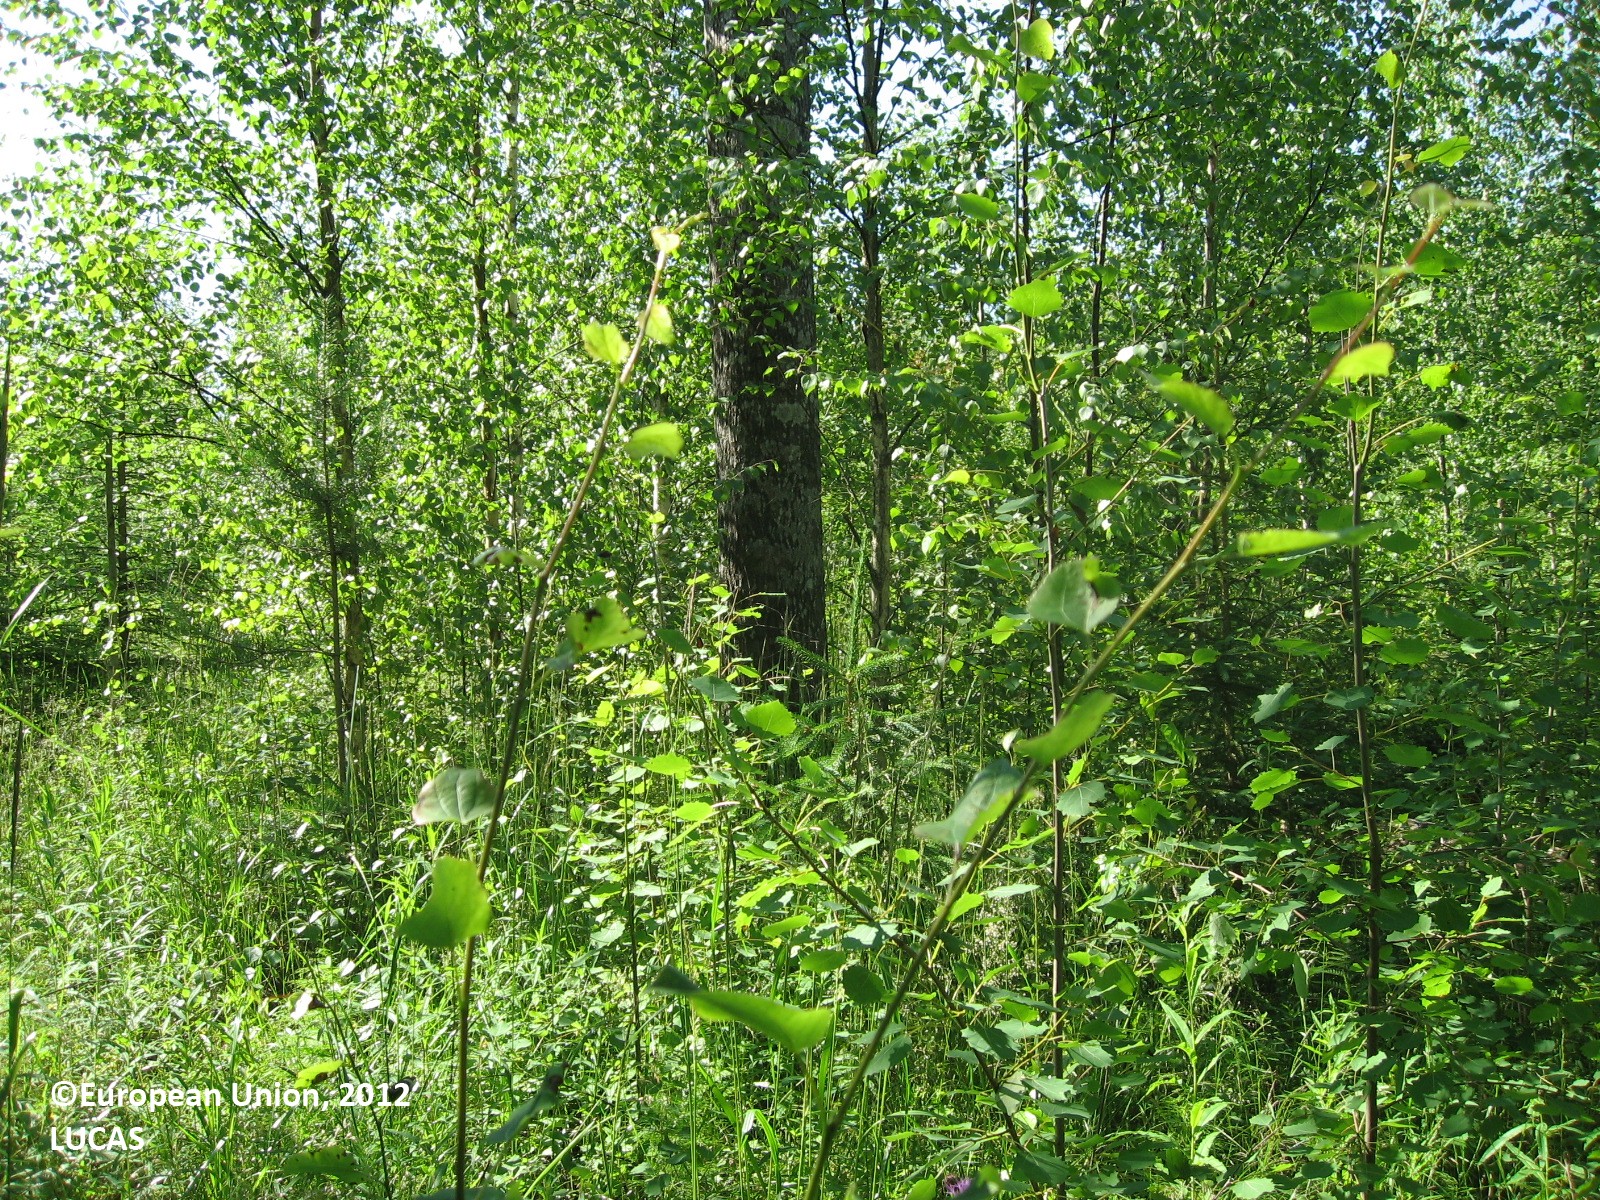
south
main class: Woodland
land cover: Spruce dominated mixed woodland
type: boreal forest
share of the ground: 50 - 75 %
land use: Forestry
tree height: > 5 m
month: July
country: FI
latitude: 60.9533
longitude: 26.4925
